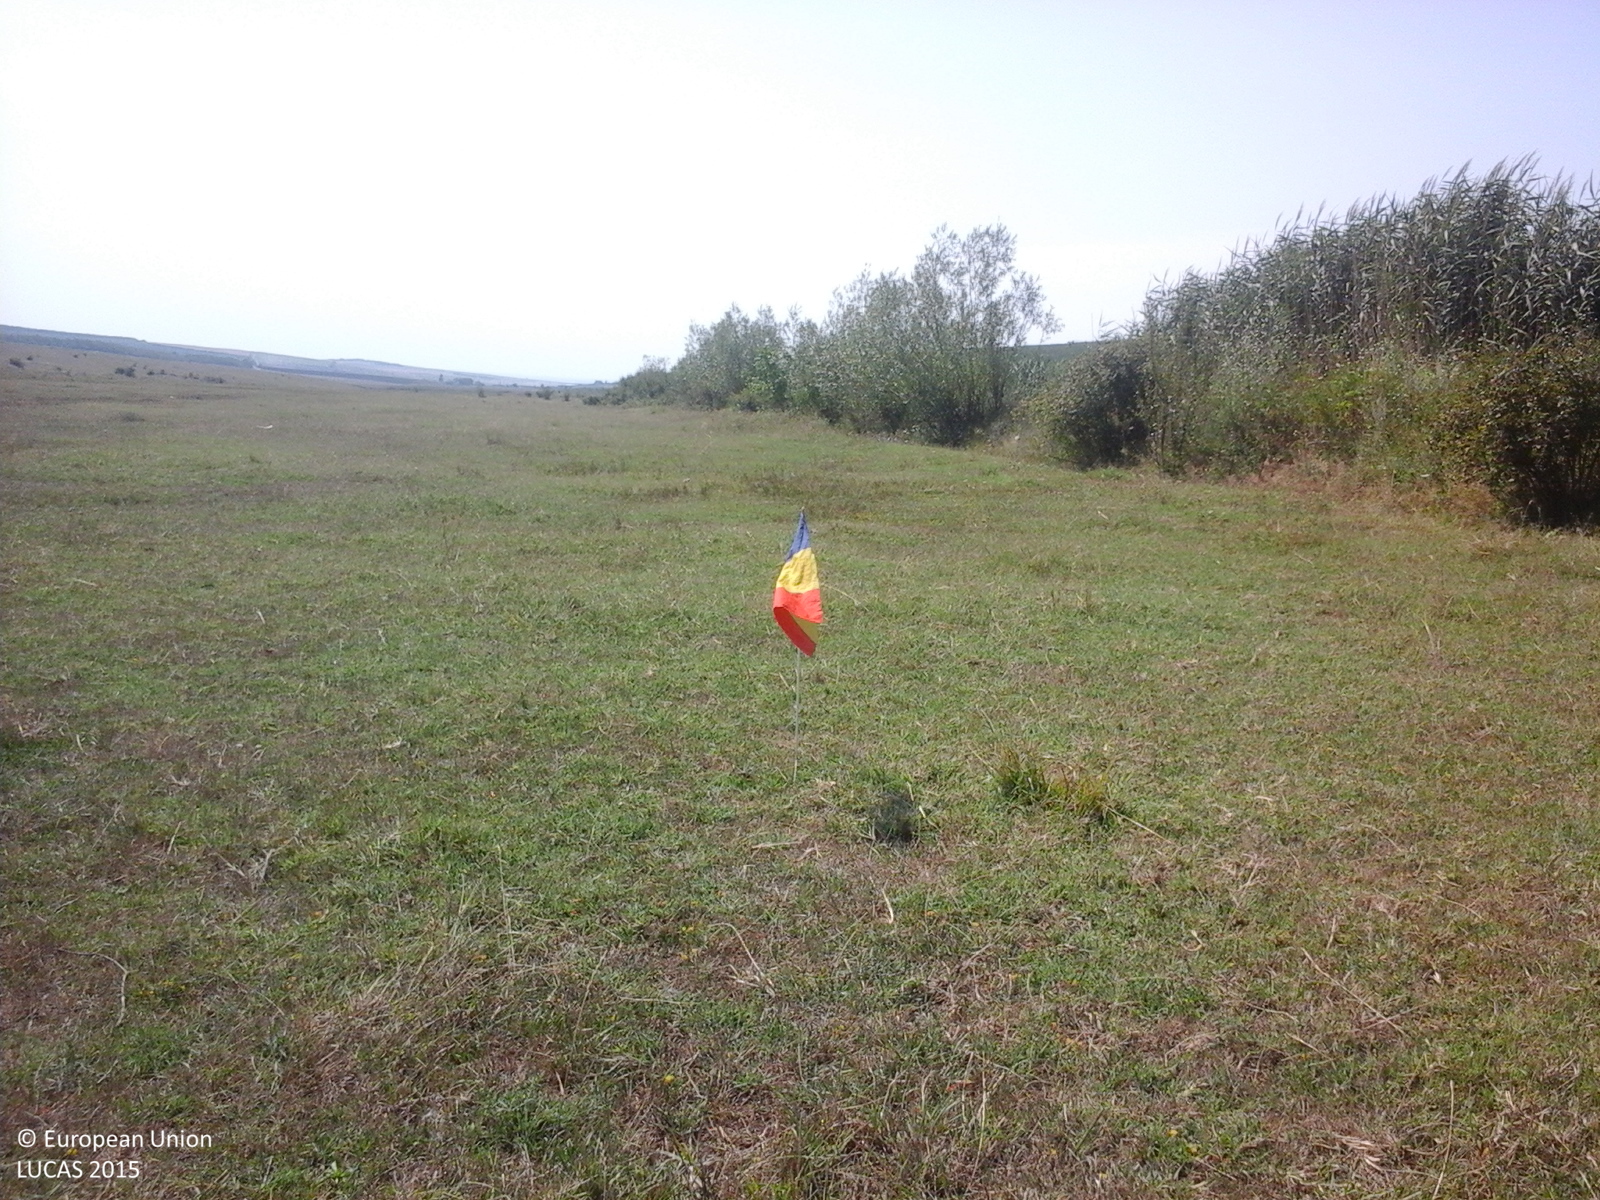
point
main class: Grassland
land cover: Grassland without tree/shrub cover
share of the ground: > 75 %
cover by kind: herbaceous plants 100 %
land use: Agriculture (excluding fallow land and kitchen gardens)
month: July
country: RO
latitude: 46.3443
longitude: 28.0711
